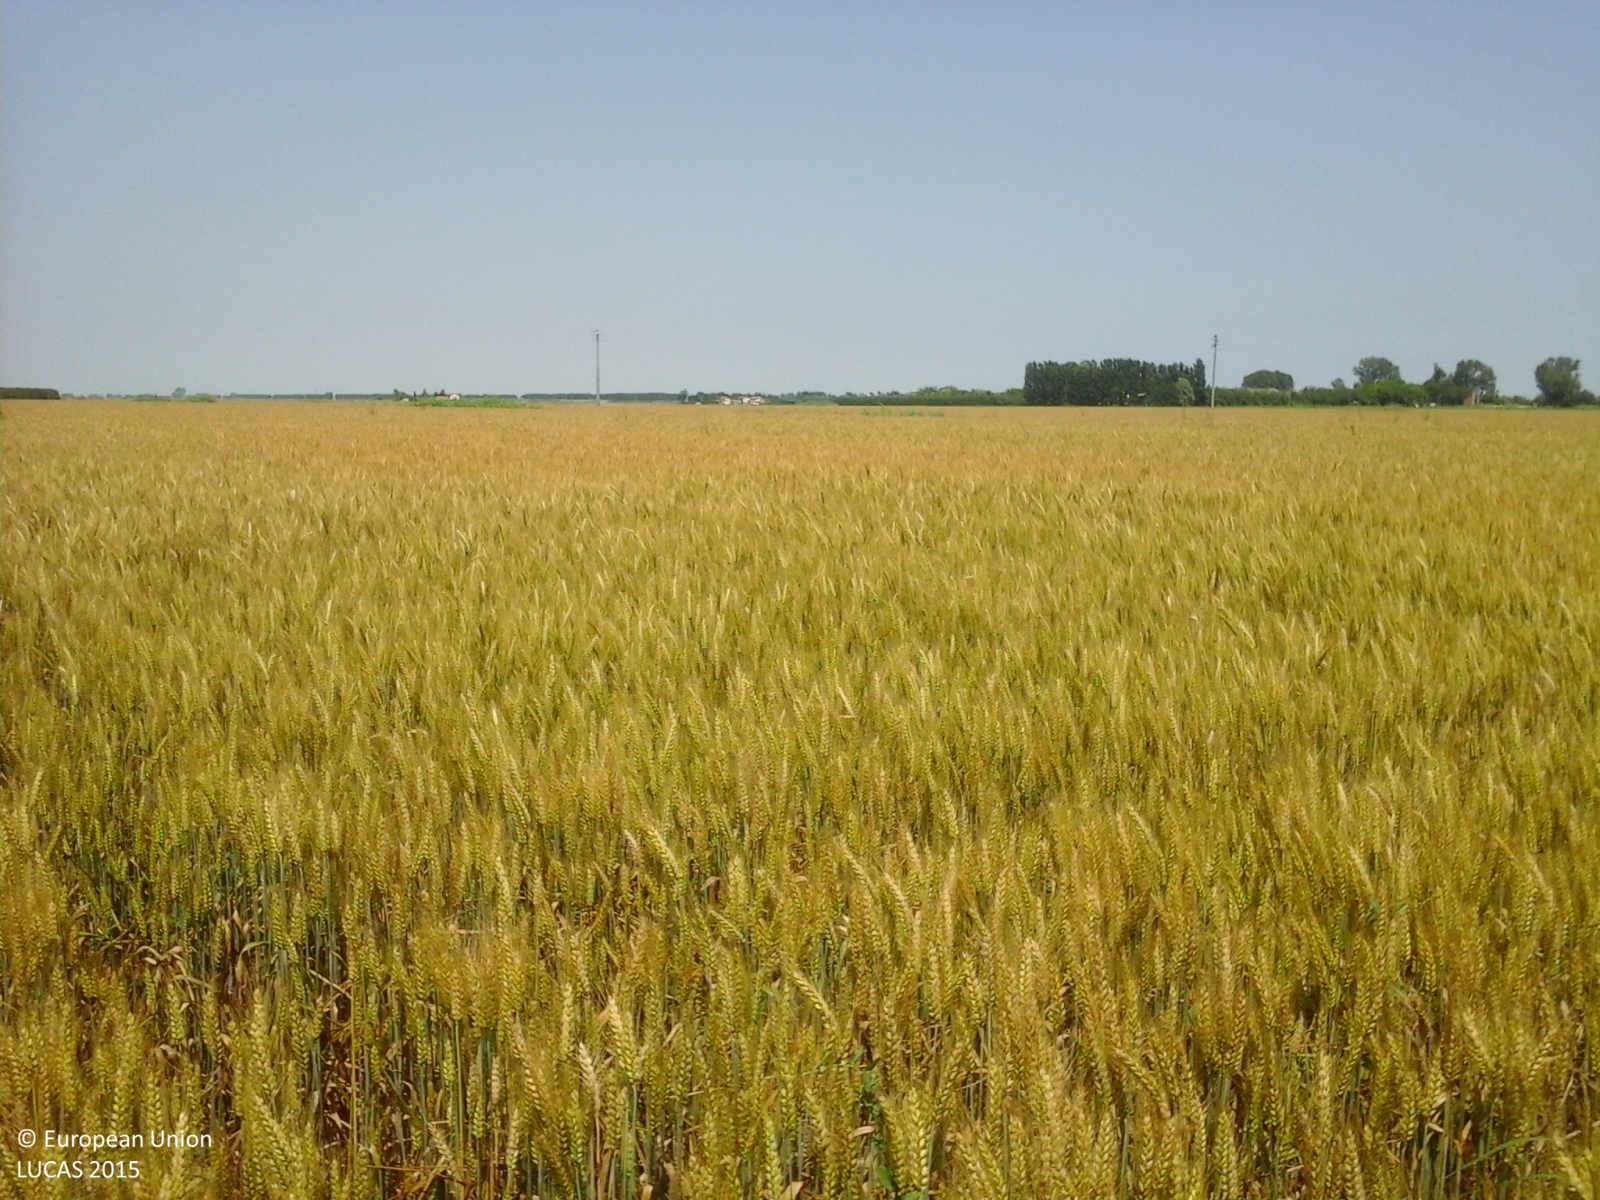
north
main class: Cropland
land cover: Common wheat
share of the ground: > 75 %
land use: Agriculture (excluding fallow land and kitchen gardens)
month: June
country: IT
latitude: 44.7246
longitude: 12.1799
